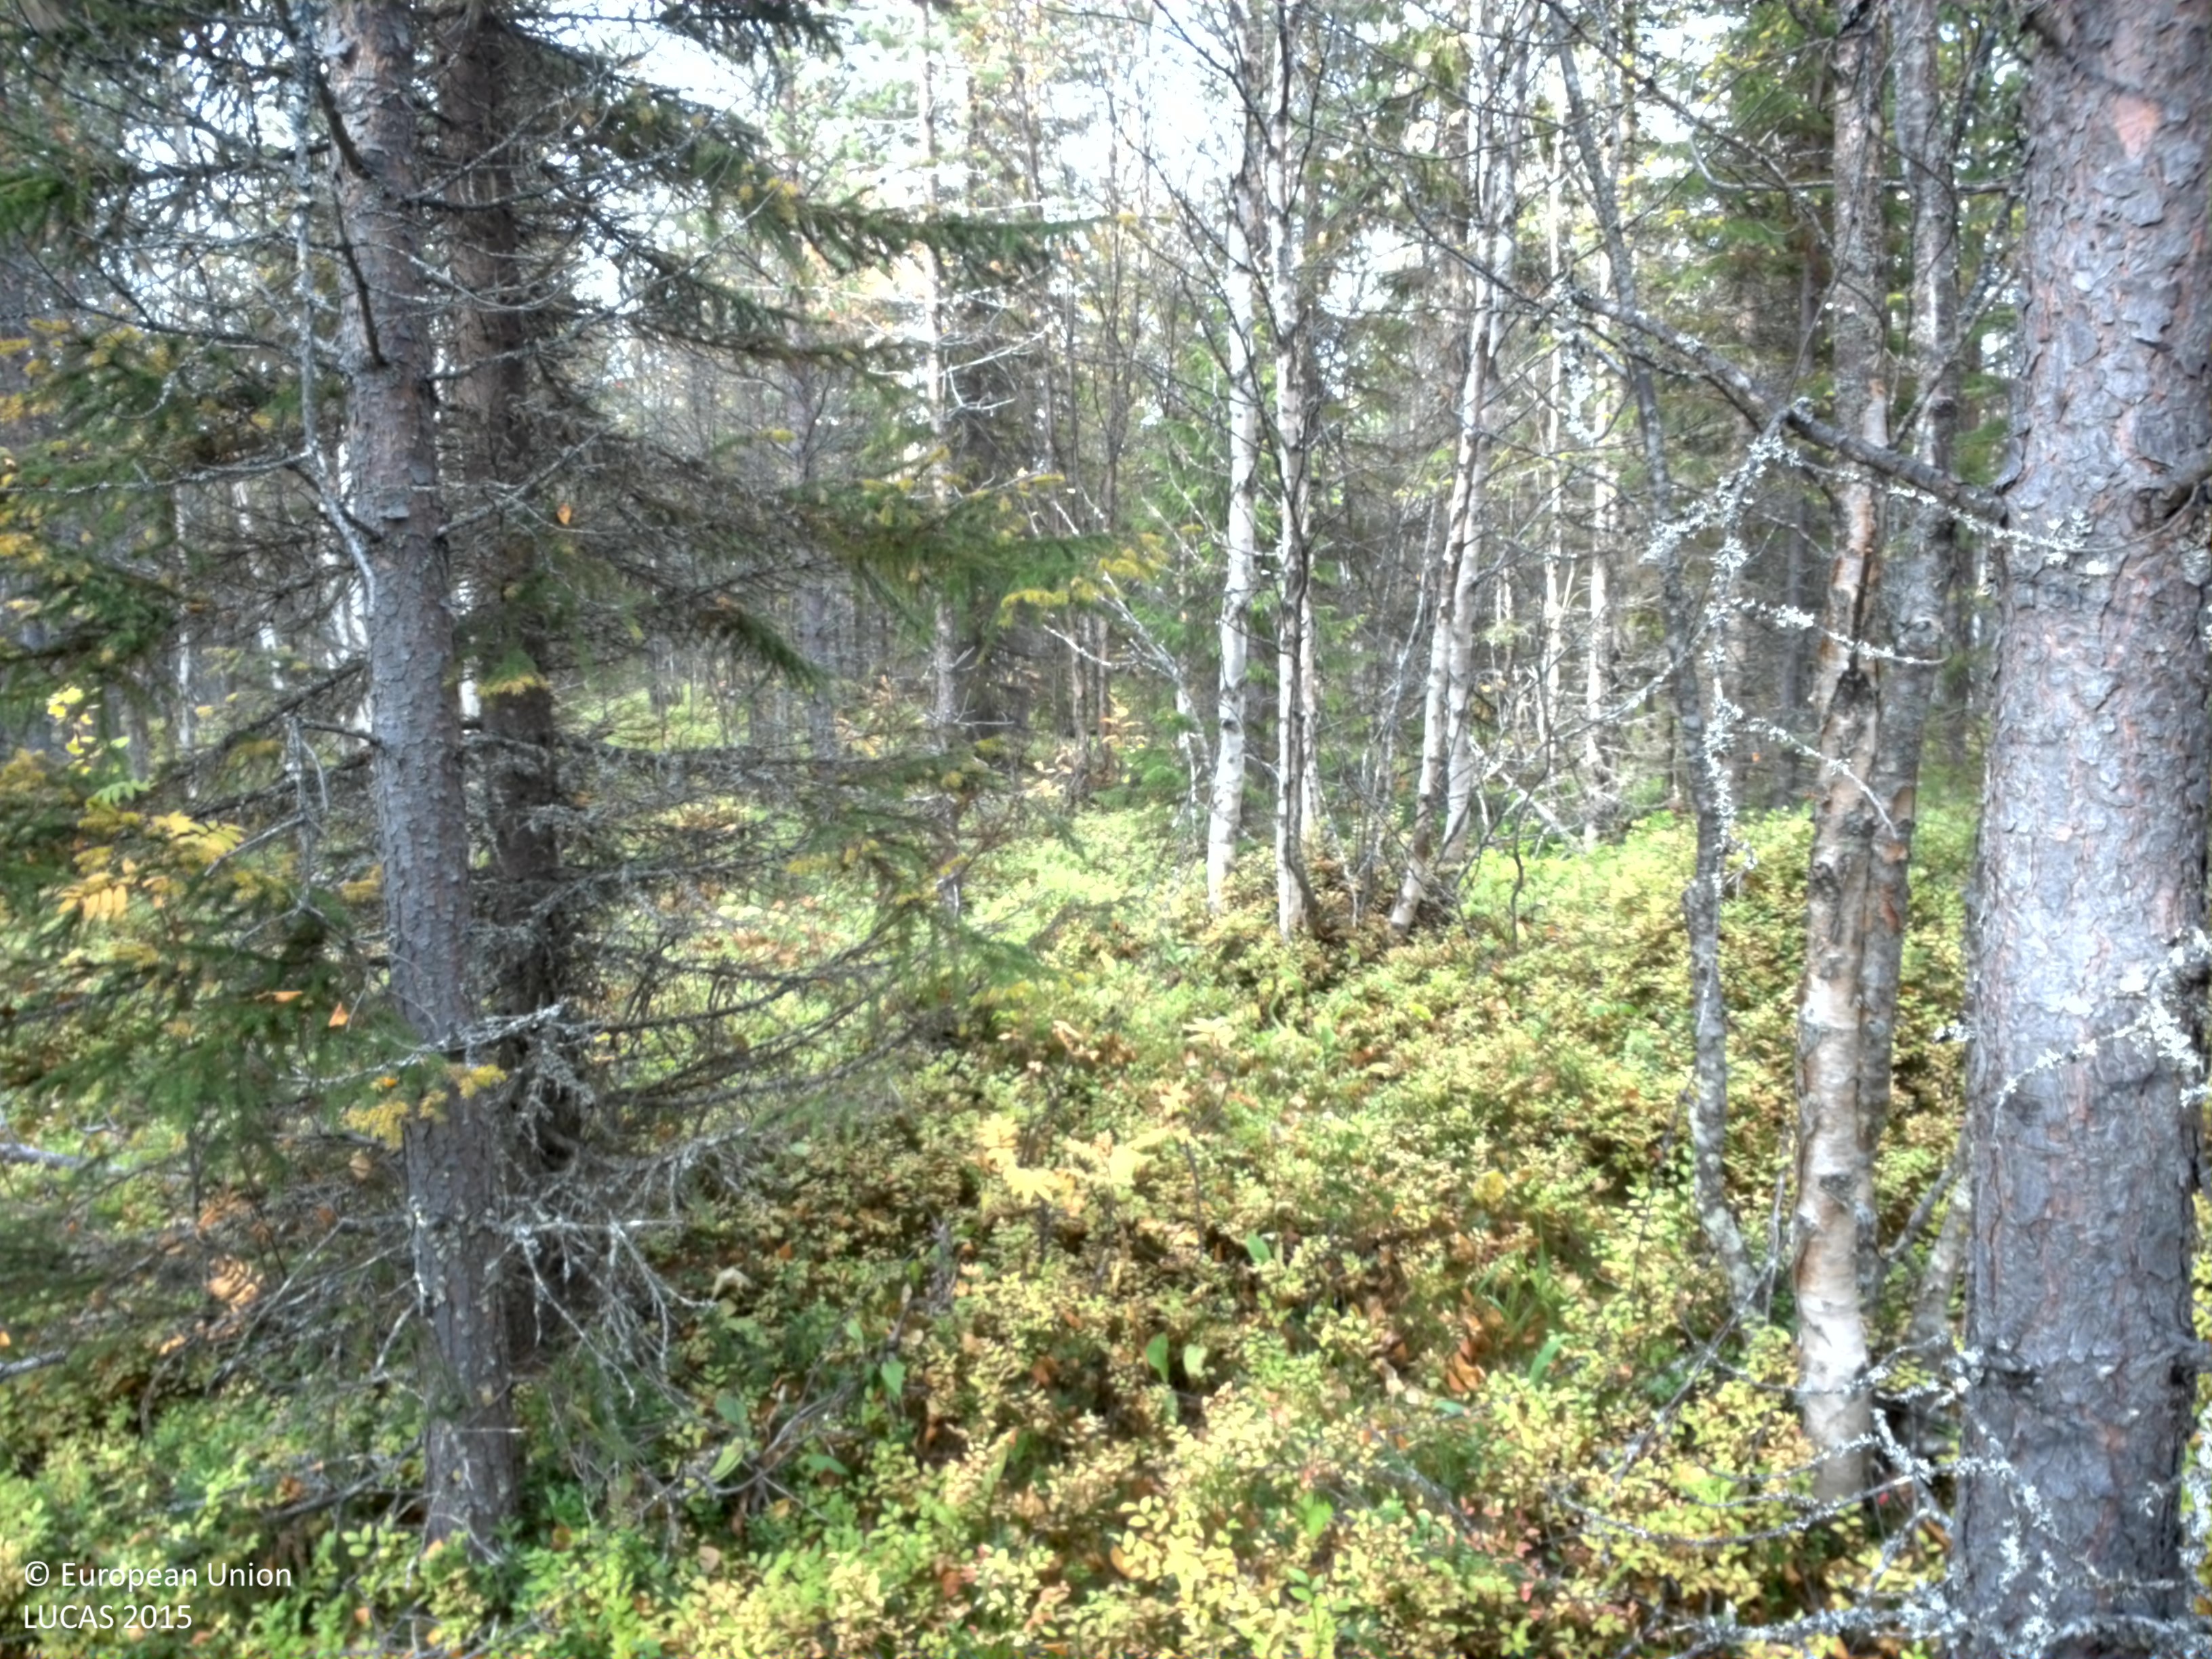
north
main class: Woodland
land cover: Pine dominated mixed woodland
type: boreal forest
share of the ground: 25 - 50 %
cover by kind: coniferous forest trees 30 %, shrubs 30 %, herbaceous plants 20 %, broadleaved forest trees 10 %, lichens and mosses 10 %
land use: Forestry
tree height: > 5 m
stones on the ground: < 10 %
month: October
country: SE
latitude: 64.9858
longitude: 17.4457
